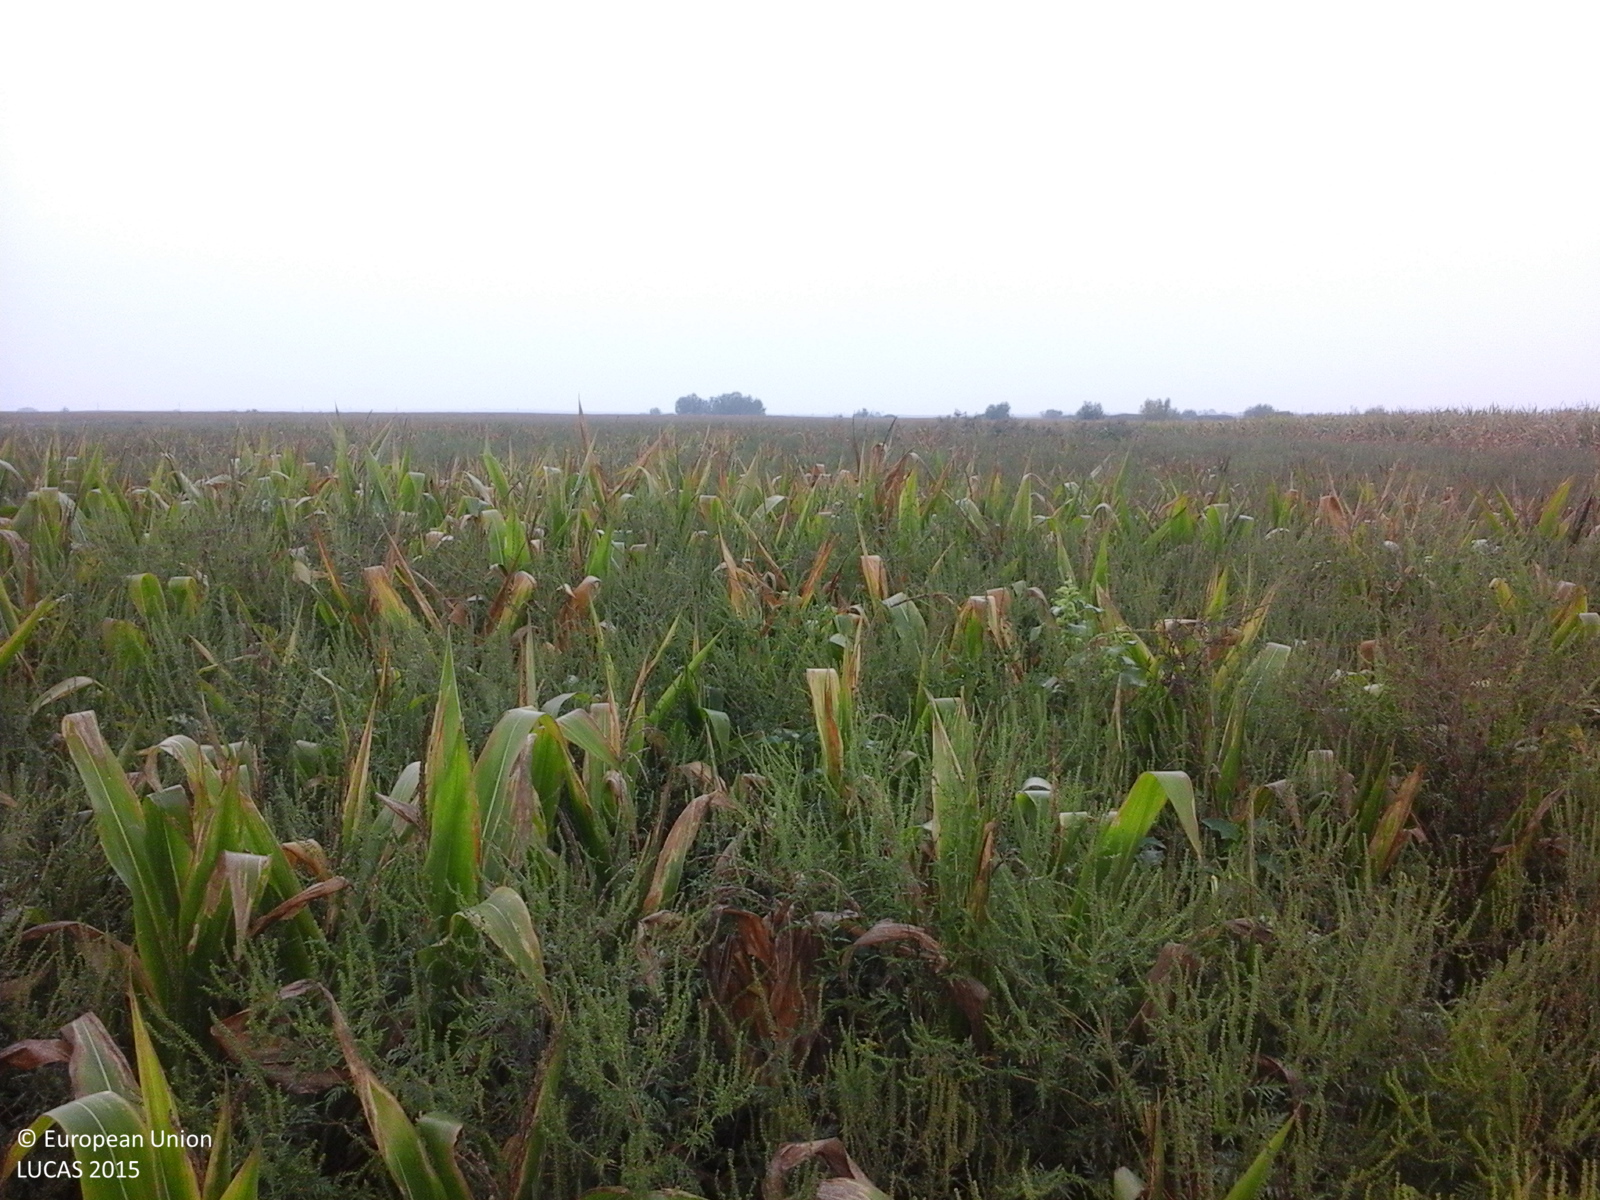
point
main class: Cropland
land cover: Maize
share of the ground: > 75 %
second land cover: Spontaneously vegetated surfaces
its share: > 75 %
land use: Agriculture (excluding fallow land and kitchen gardens)
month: September
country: RO
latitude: 47.4090
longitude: 22.0969
